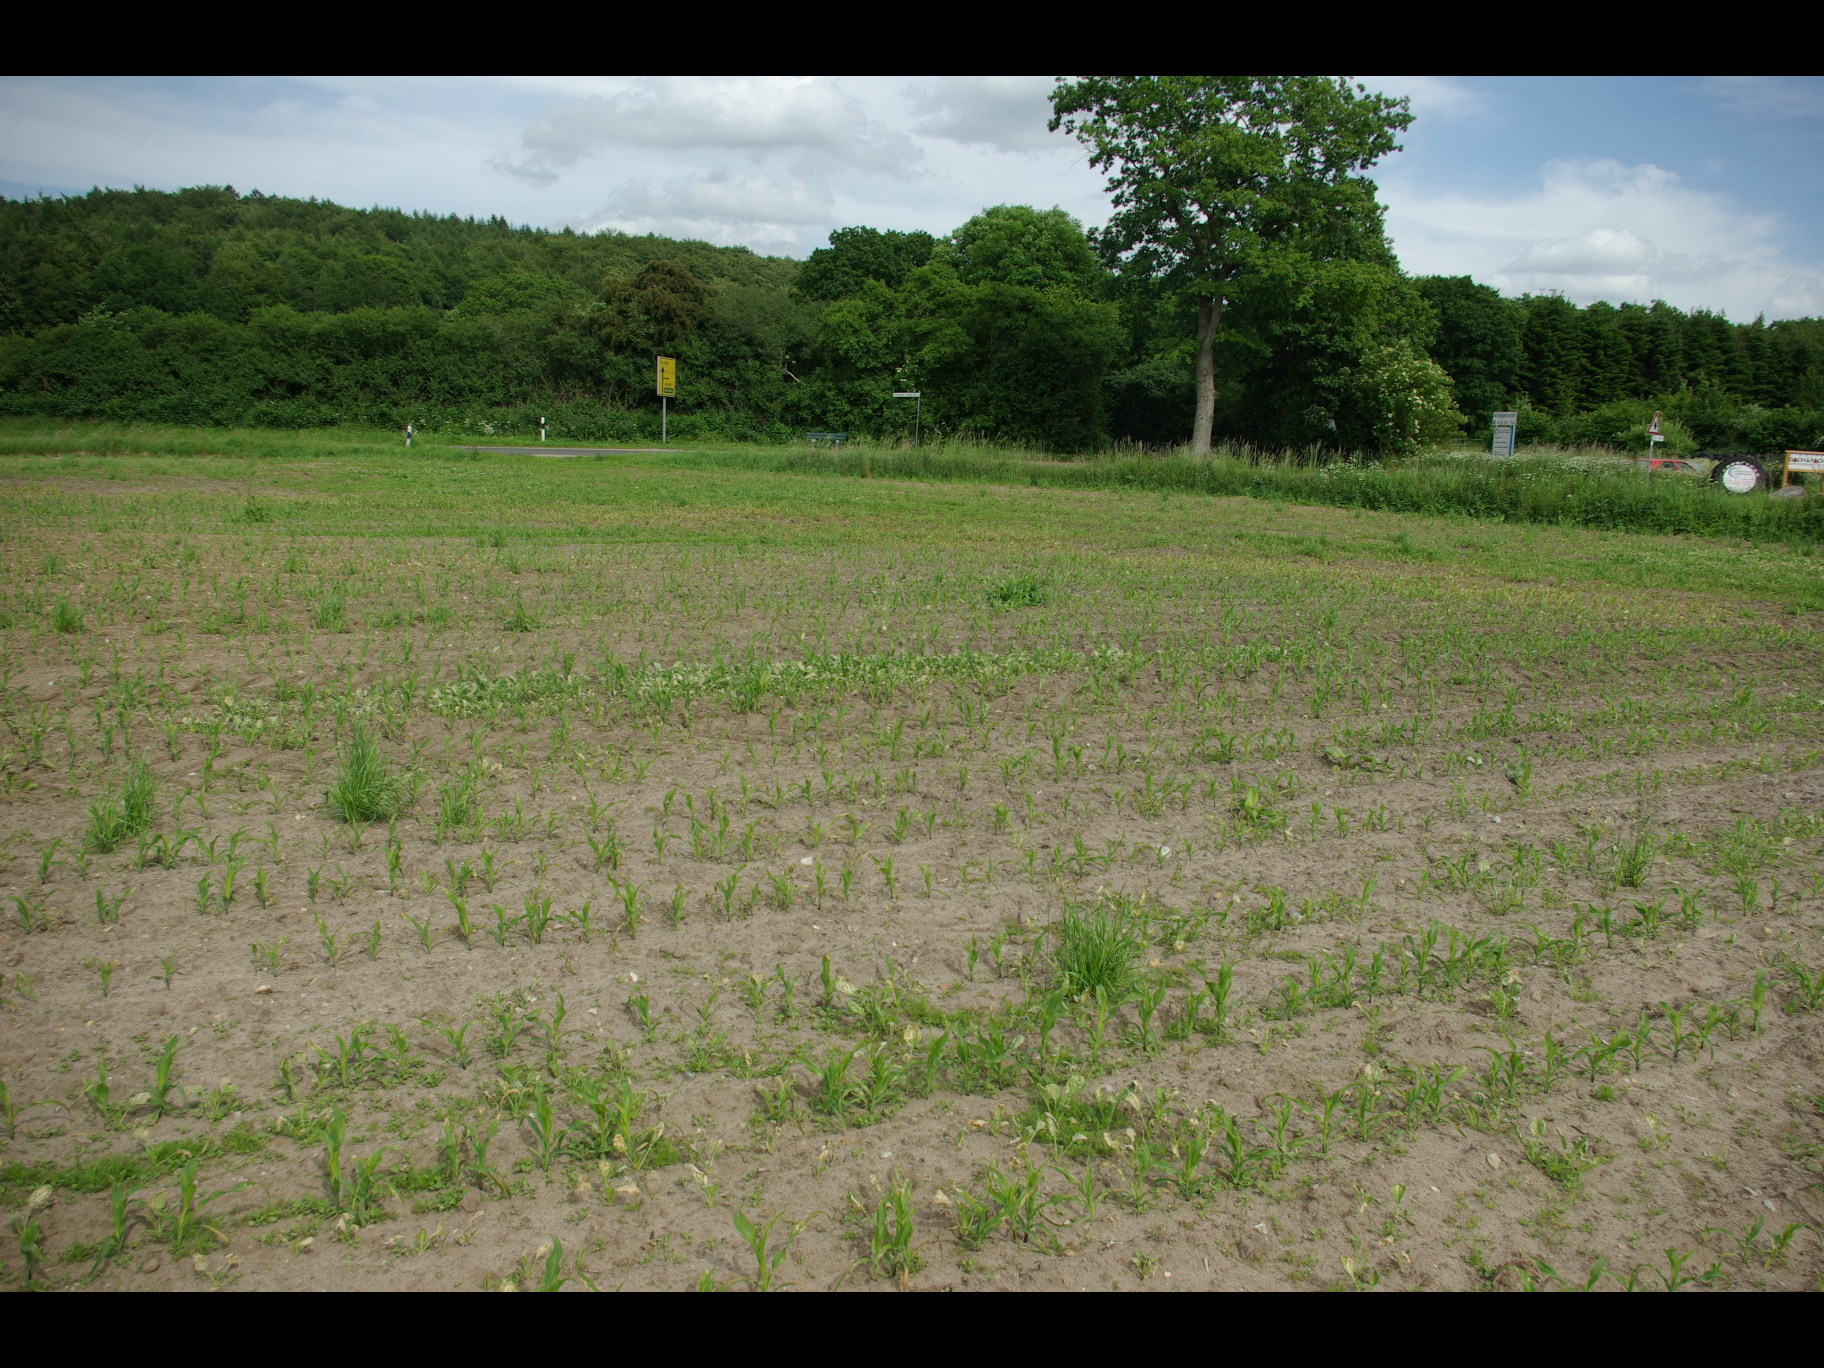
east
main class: Cropland
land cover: Maize
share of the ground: 10 - 25 %
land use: Agriculture (excluding fallow land and kitchen gardens)
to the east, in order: Maize; Spontaneously vegetated surfaces; Paved roads, cycling and walking lanes; Grassland without tree/shrub cover; Shrubland without tree cover; Fences; Other coniferous woodland; Fences; Broadleaved woodland; Tracks; Spontaneously vegetated surfaces; Fences; Other coniferous woodland; Grassland without tree/shrub cover; Artificial constructions in urban areas; Other coniferous woodland
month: June
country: DE
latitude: 54.4258
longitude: 9.6457
